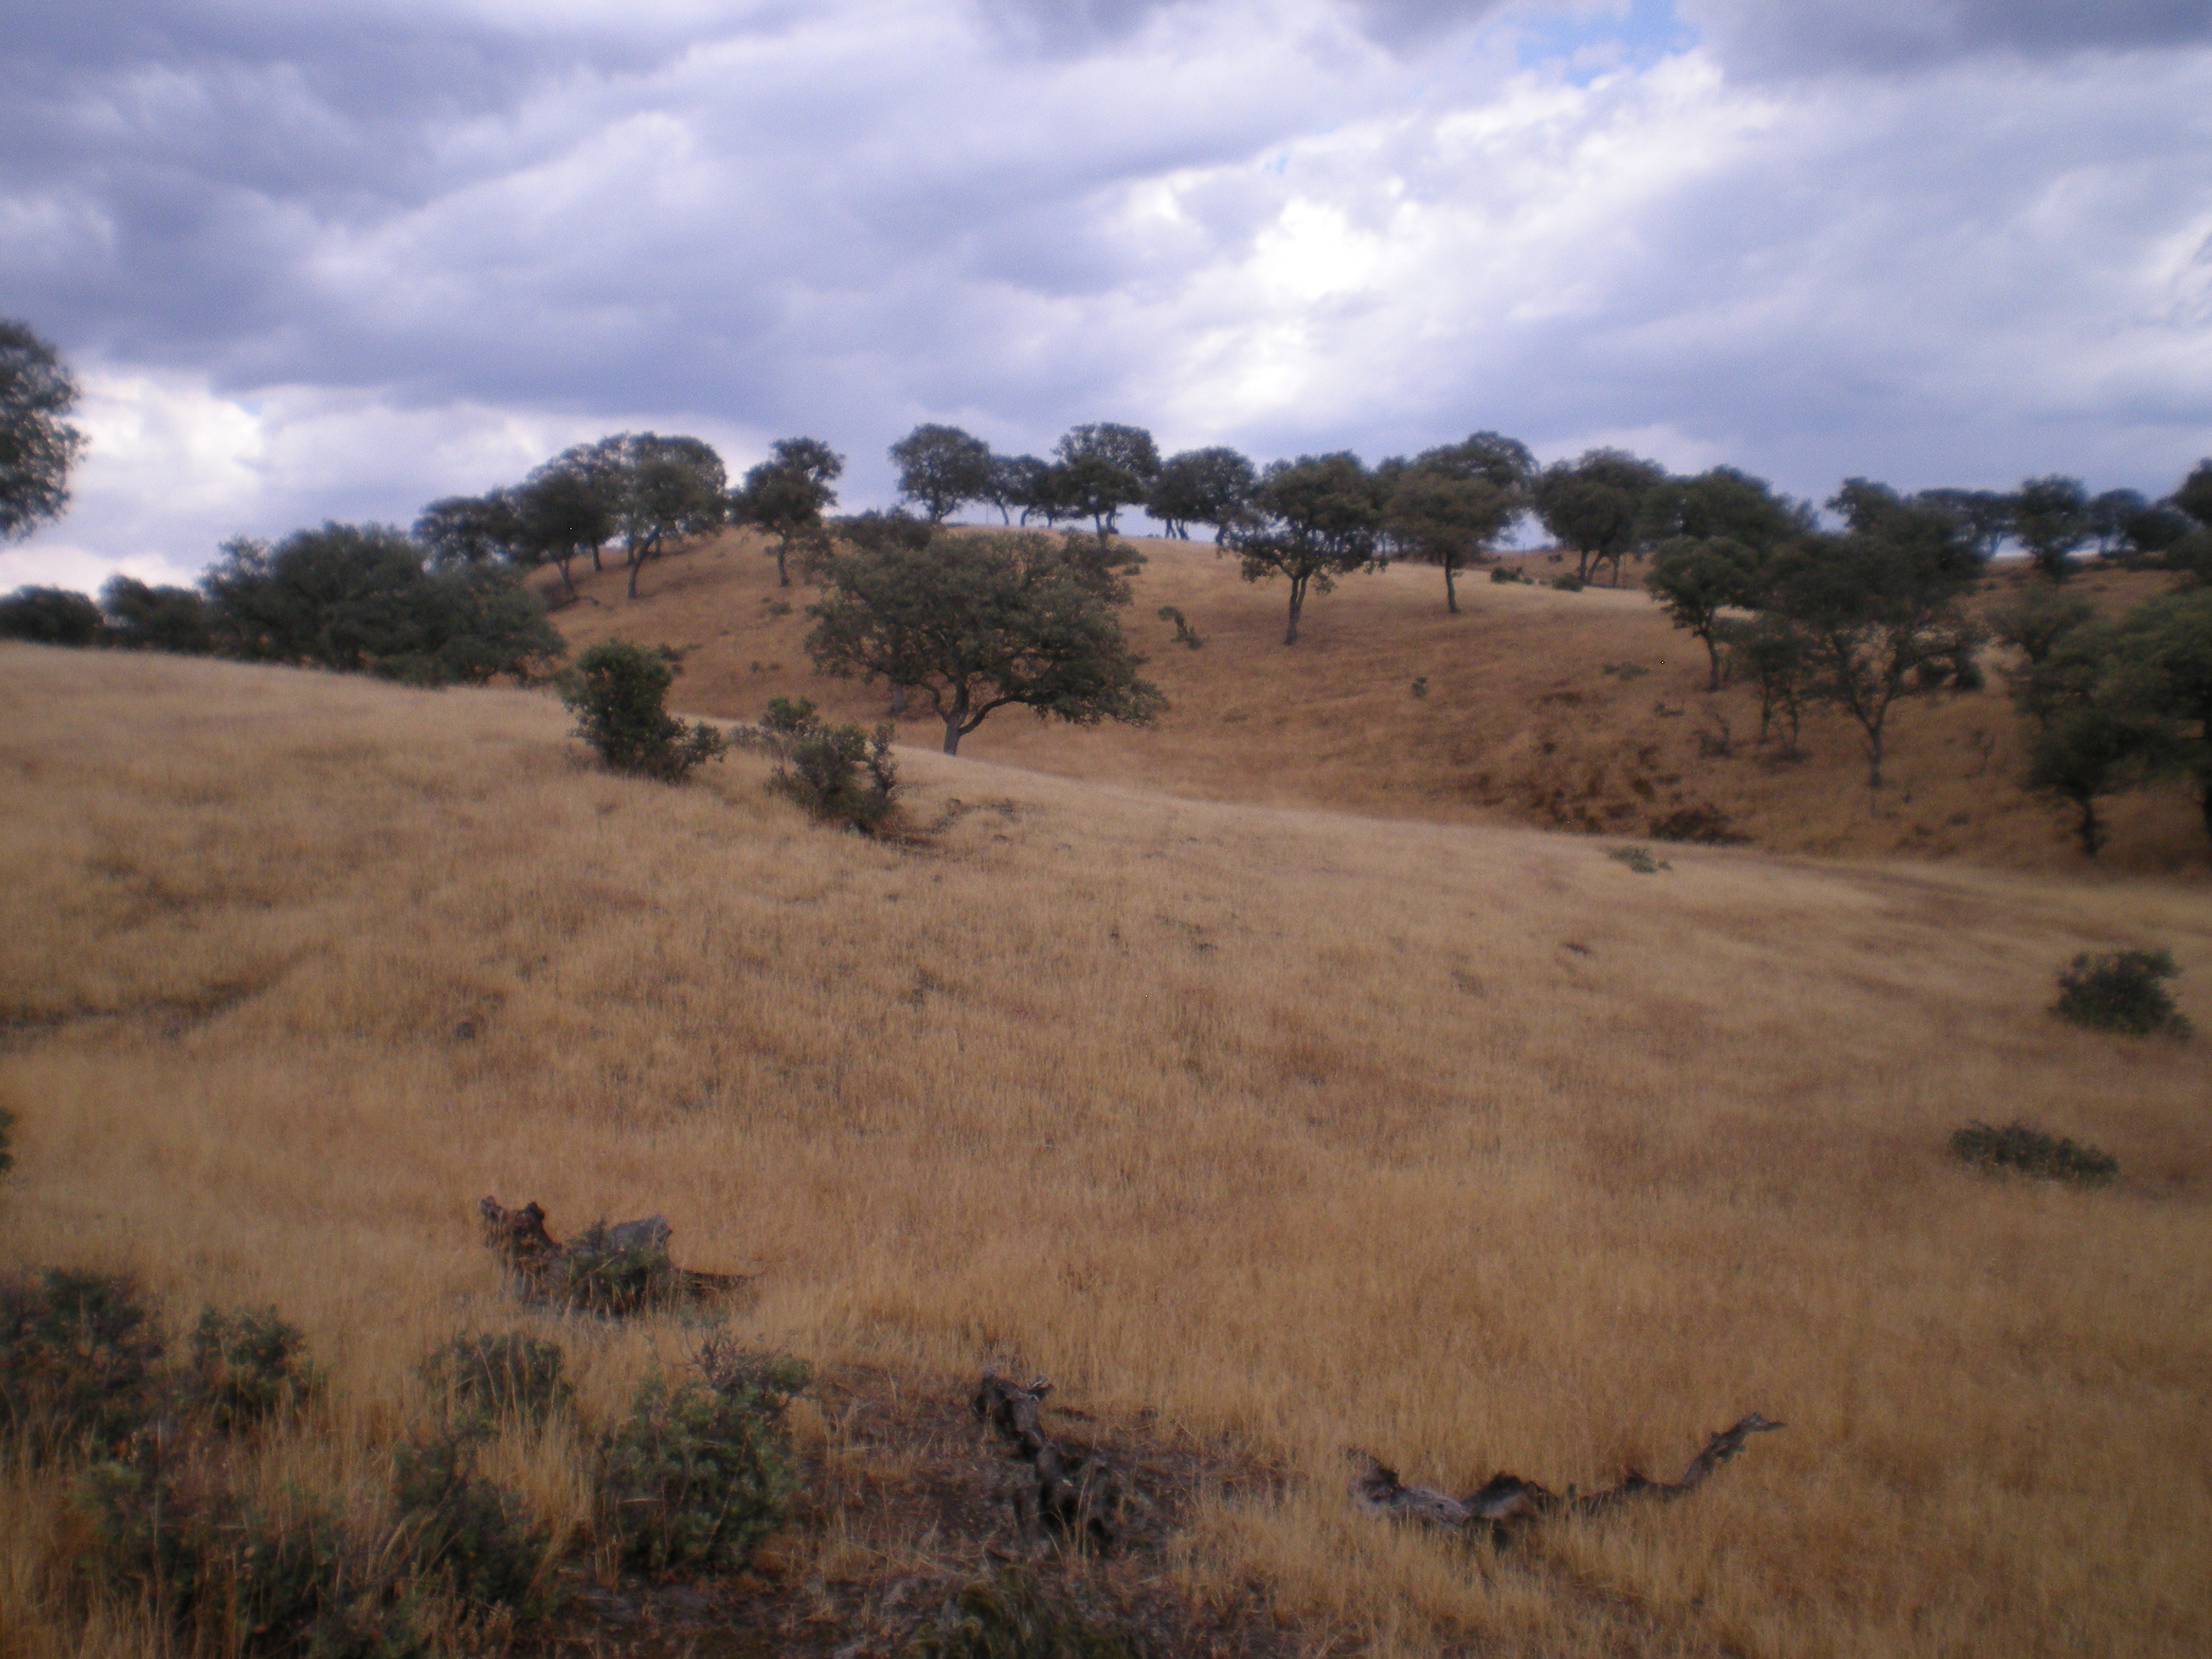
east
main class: Grassland
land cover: Grassland with sparse tree/shrub cover
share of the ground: 10 - 25 %
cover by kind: unconsolidated bare surface 80 %, herbaceous plants 15 %, broadleaved forest trees 5 %
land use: Agriculture (excluding fallow land and kitchen gardens)
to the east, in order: Grassland with sparse tree/shrub cover; Broadleaved woodland; Fences; Broadleaved woodland; Tracks; Broadleaved woodland
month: June
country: ES
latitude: 38.4519
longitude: -3.3557
